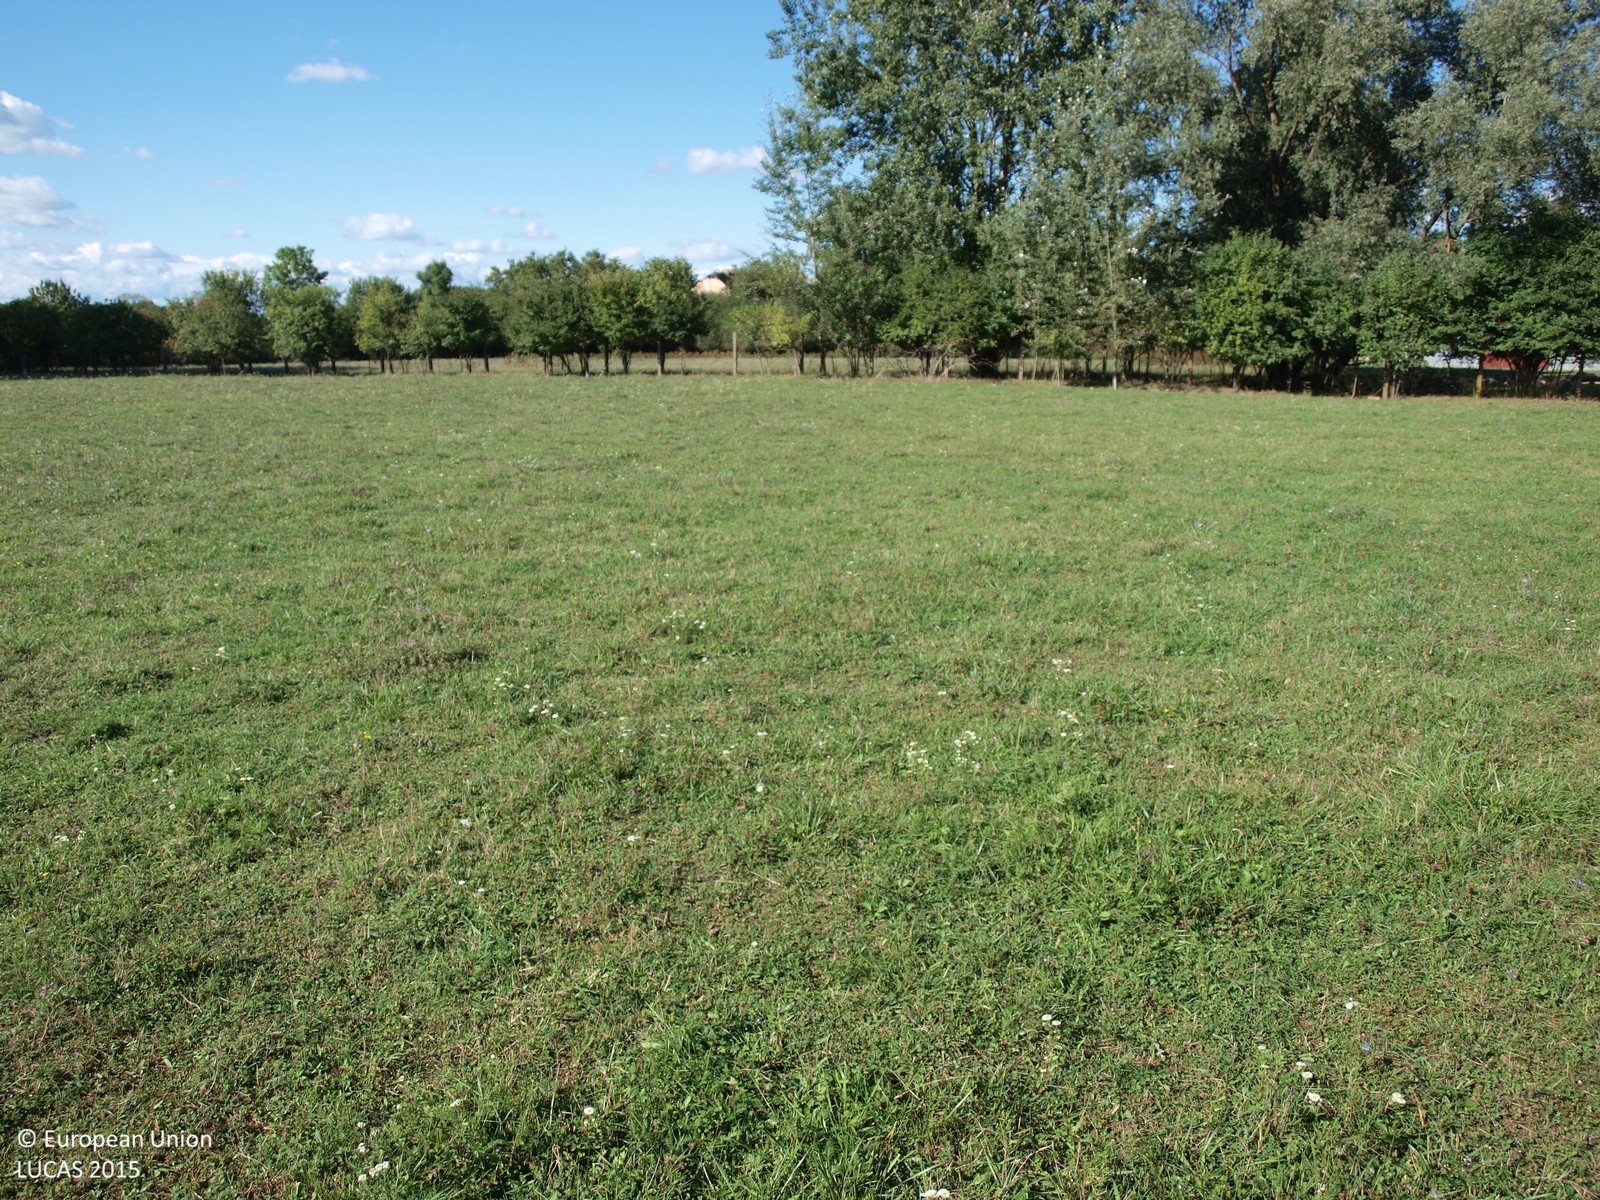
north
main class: Grassland
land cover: Grassland without tree/shrub cover
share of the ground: > 75 %
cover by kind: herbaceous plants 100 %
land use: Agriculture (excluding fallow land and kitchen gardens)
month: September
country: HR
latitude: 45.6565
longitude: 16.3508
